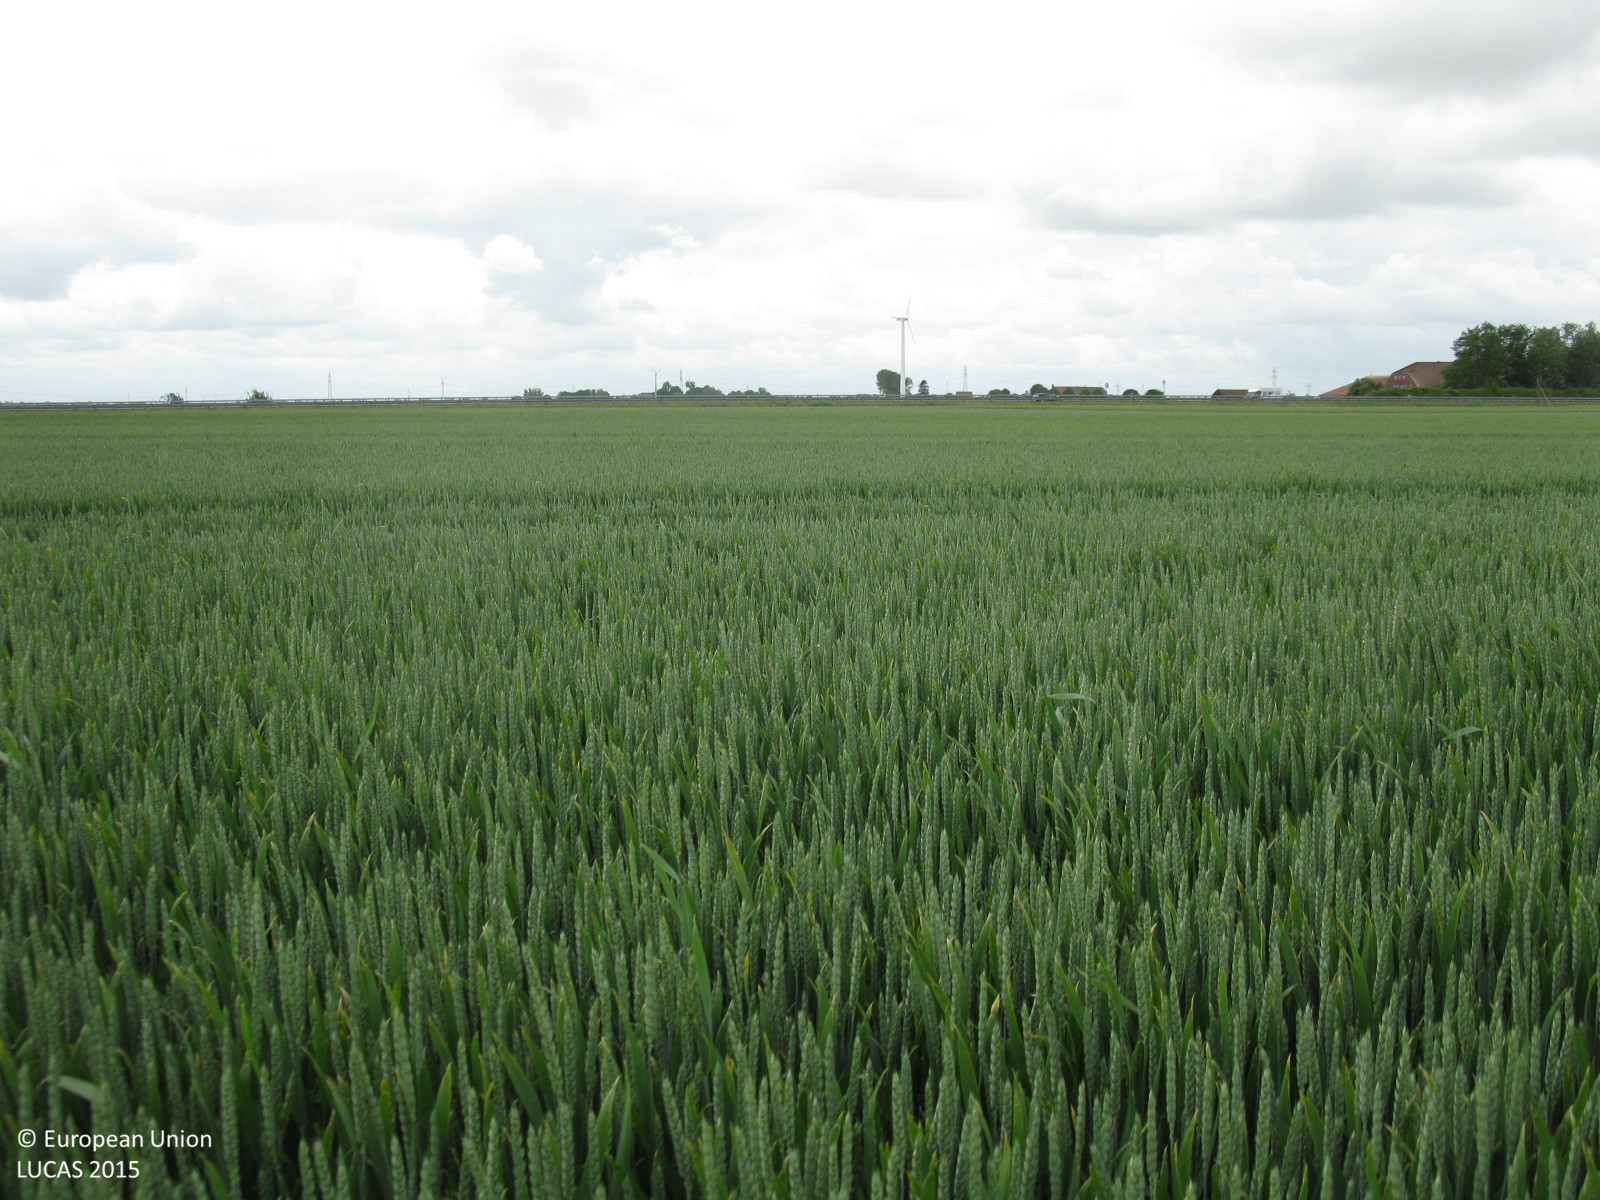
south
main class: Cropland
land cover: Common wheat
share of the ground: > 75 %
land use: Agriculture (excluding fallow land and kitchen gardens)
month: June
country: DE
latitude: 53.3721
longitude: 7.3102
